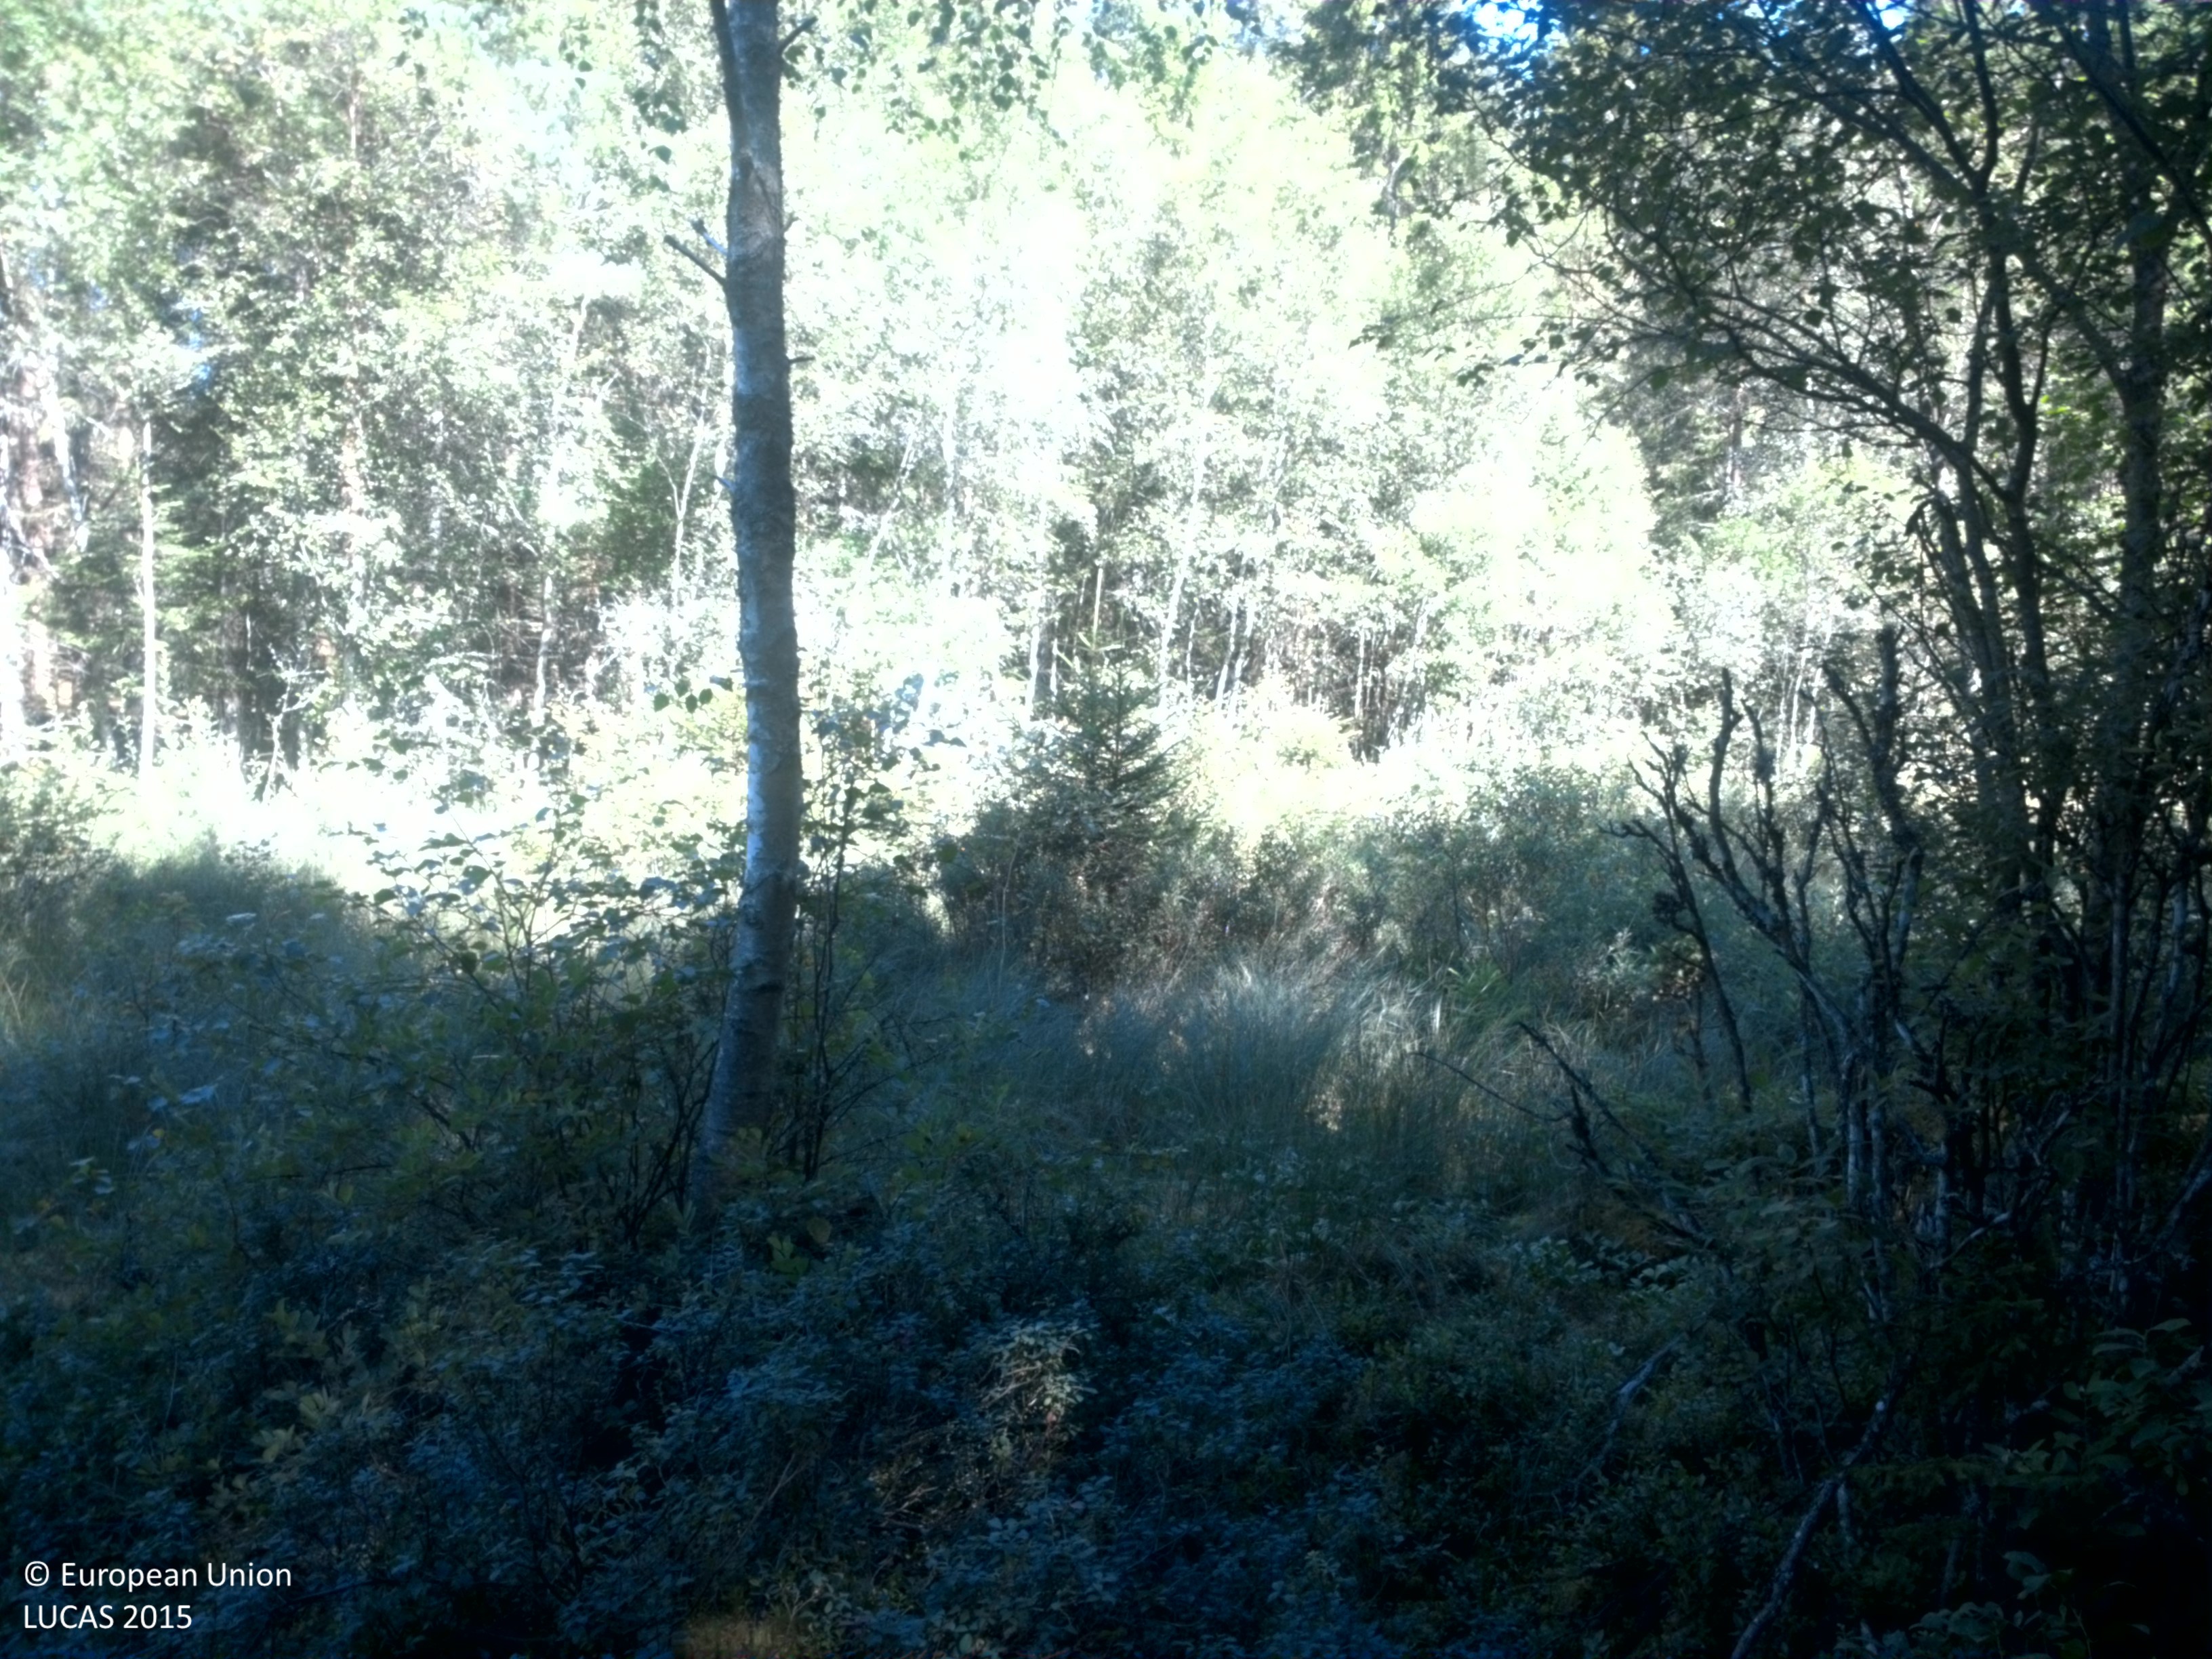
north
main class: Woodland
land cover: Spruce dominated mixed woodland
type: boreal forest
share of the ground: 50 - 75 %
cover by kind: coniferous forest trees 25 %, broadleaved forest trees 25 %, herbaceous plants 25 %, lichens and mosses 25 %
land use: Forestry
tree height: > 5 m
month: August
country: SE
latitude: 58.1249
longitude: 13.3055
